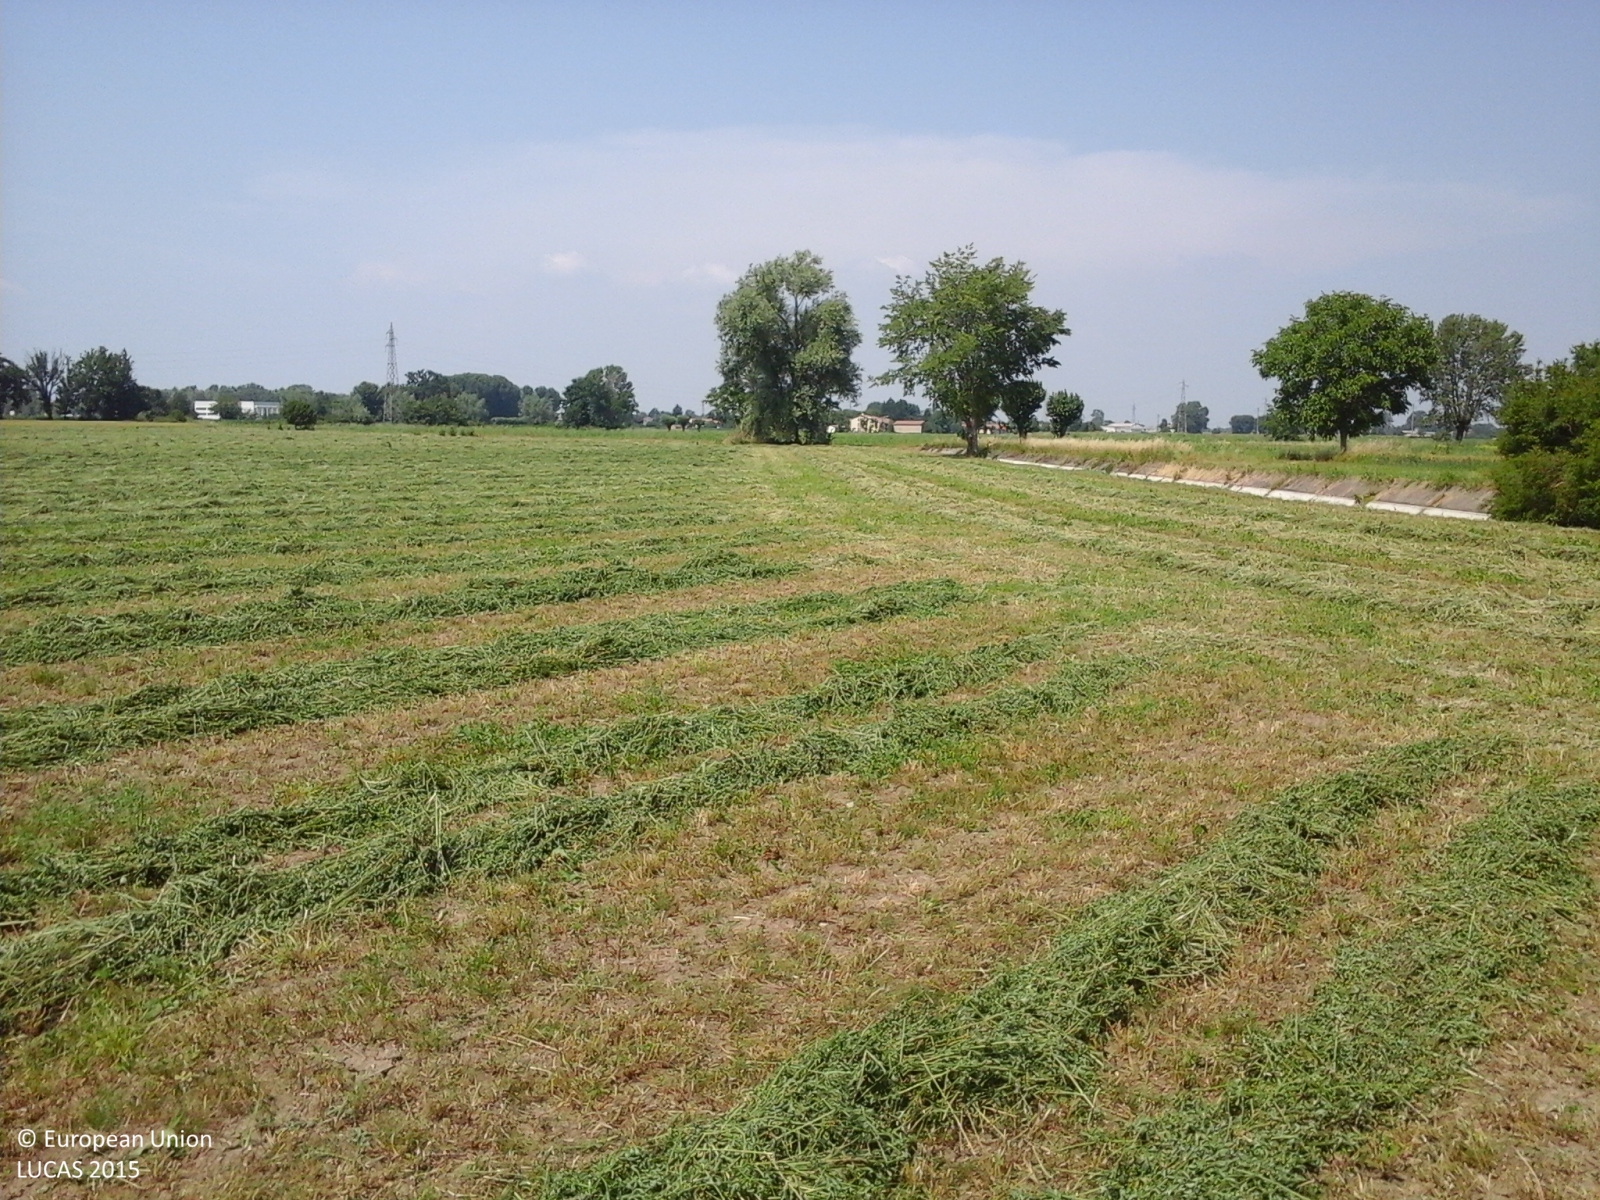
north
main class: Cropland
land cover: Lucerne
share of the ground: > 75 %
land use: Agriculture (excluding fallow land and kitchen gardens)
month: June
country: IT
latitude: 45.0718
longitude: 9.9113
